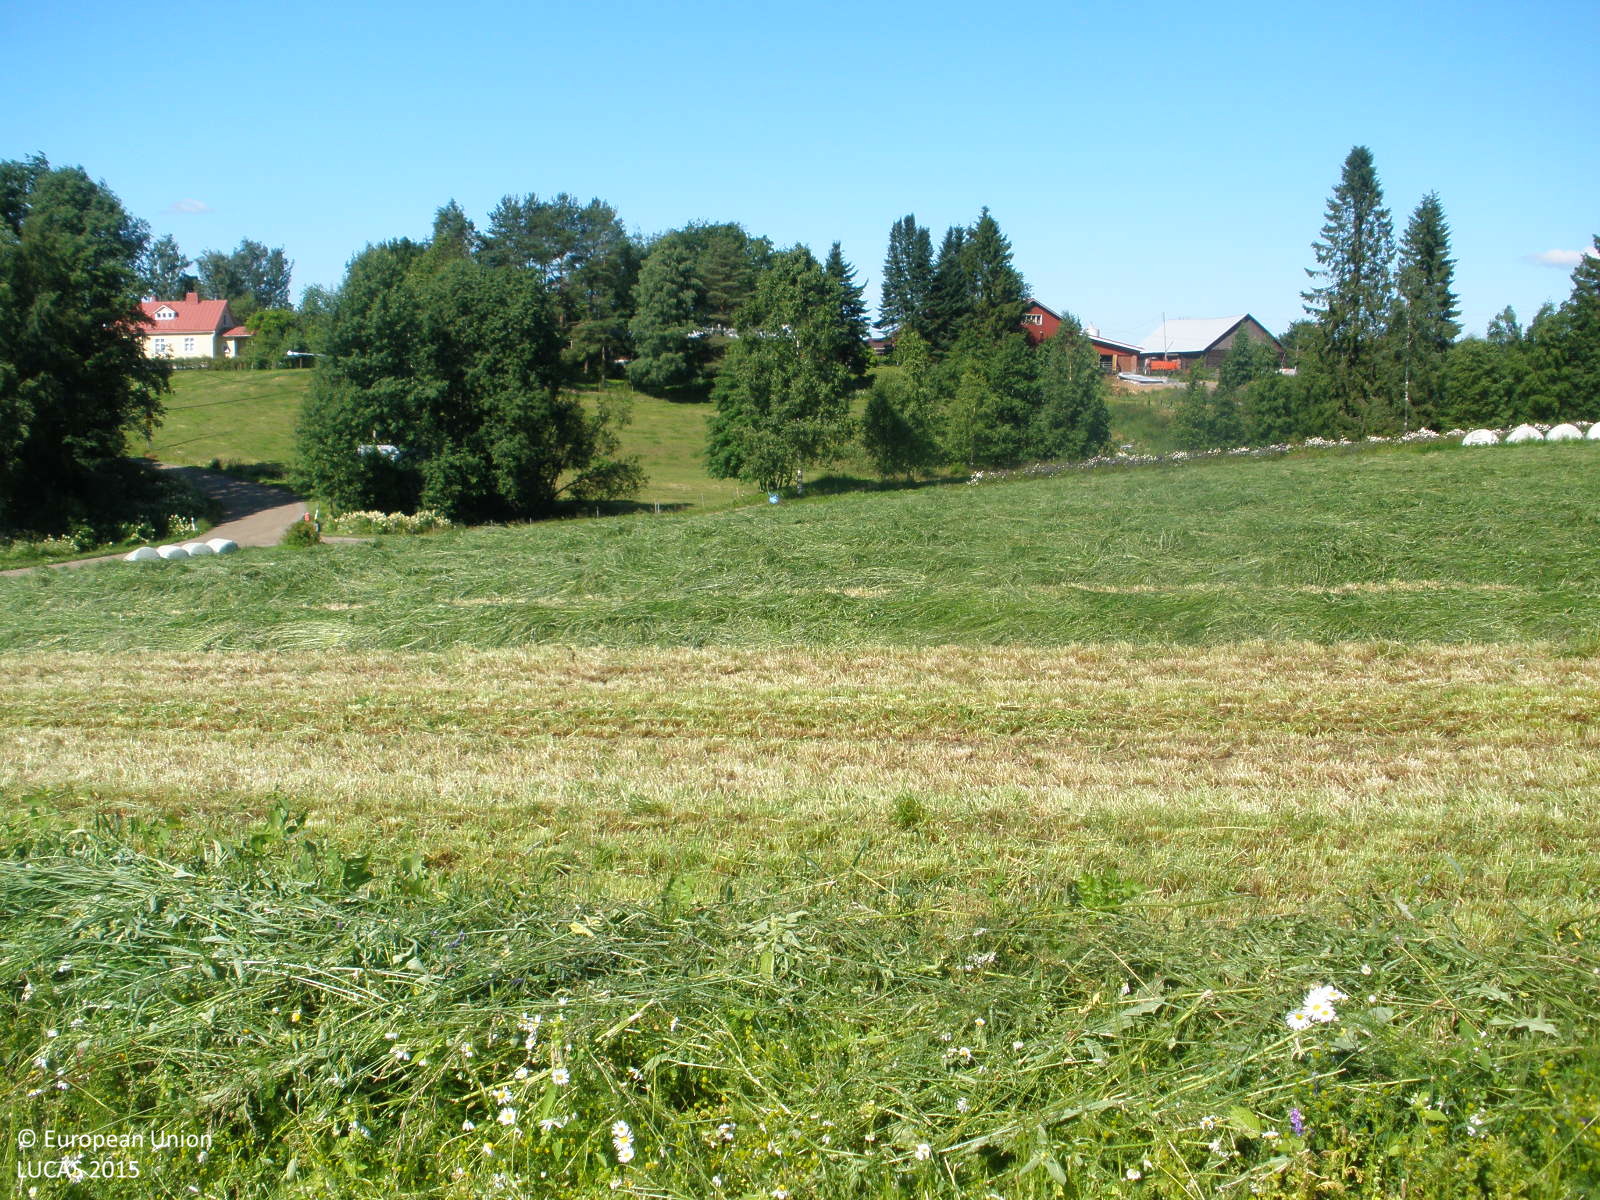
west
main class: Artificial land
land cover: Non built-up linear features
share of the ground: > 75 %
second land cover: Grassland without tree/shrub cover
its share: > 75 %
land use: Road transport
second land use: Agriculture (excluding fallow land and kitchen gardens)
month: July
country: FI
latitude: 61.0717
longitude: 24.9186
